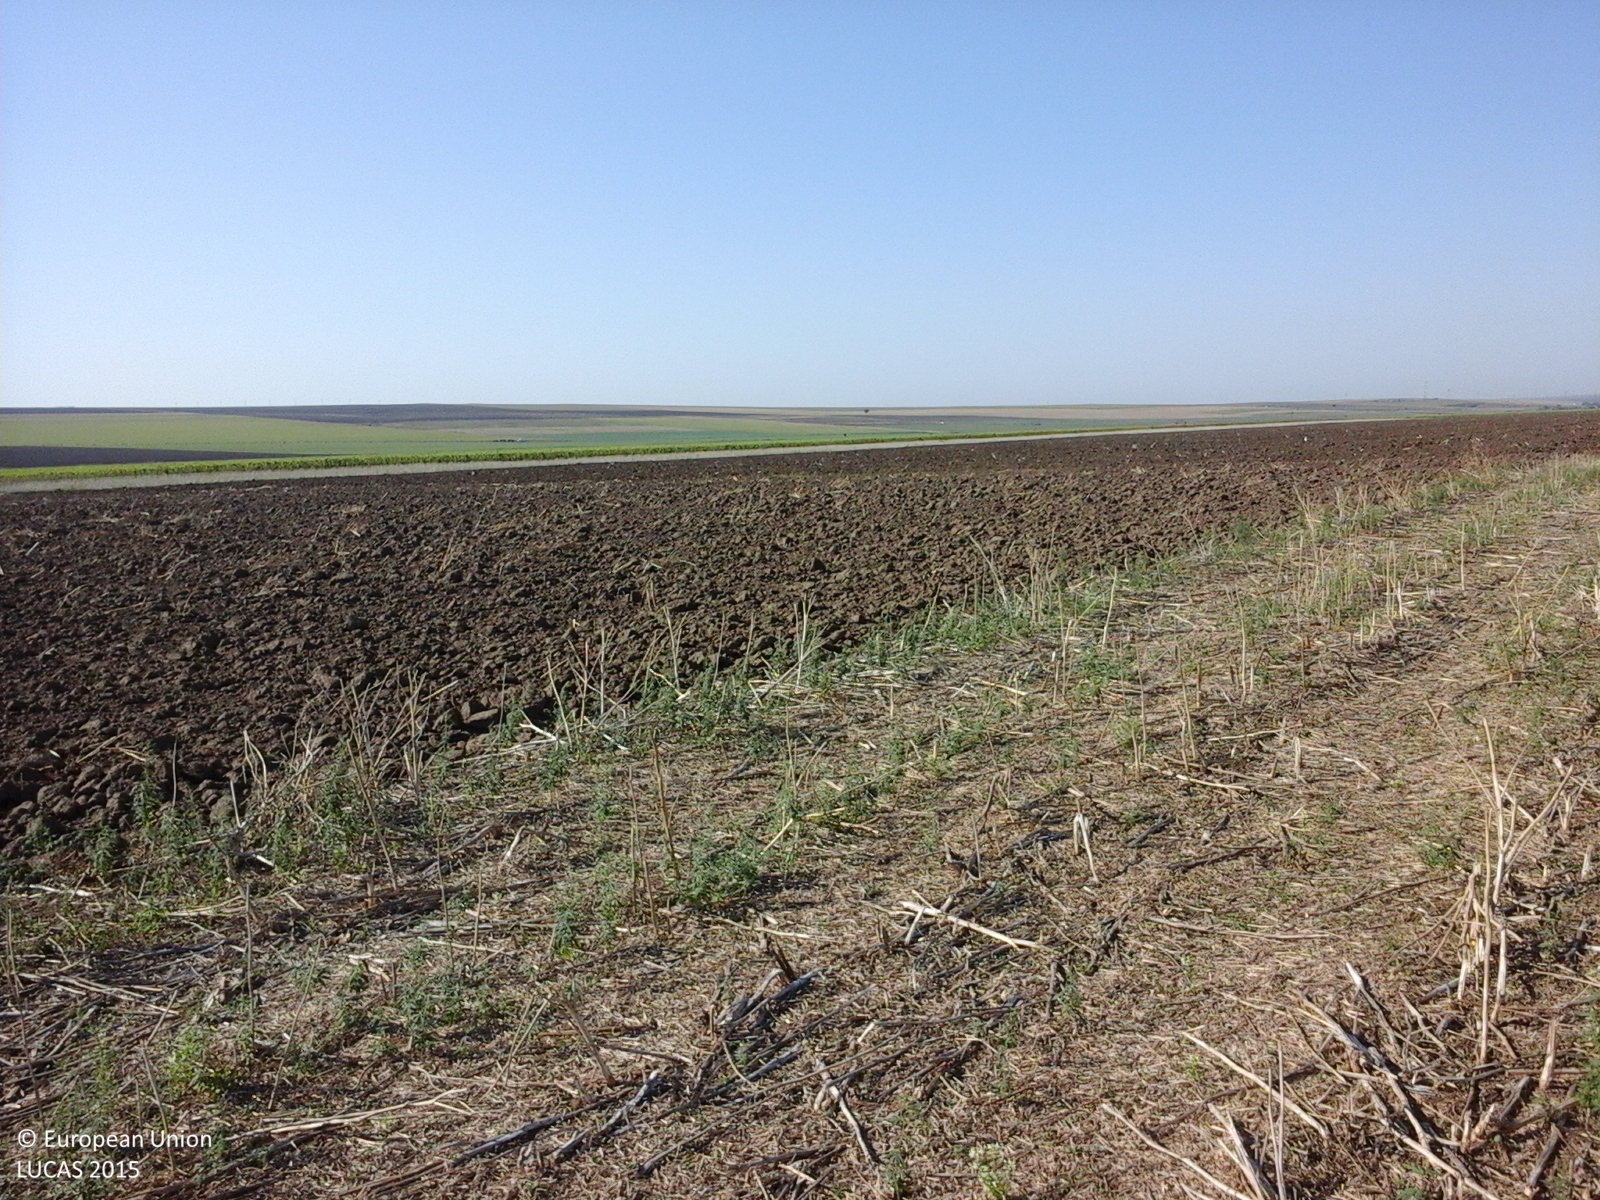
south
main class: Cropland
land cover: Rape and turnip rape
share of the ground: 25 - 50 %
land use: Agriculture (excluding fallow land and kitchen gardens)
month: August
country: RO
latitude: 44.2889
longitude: 28.4277
